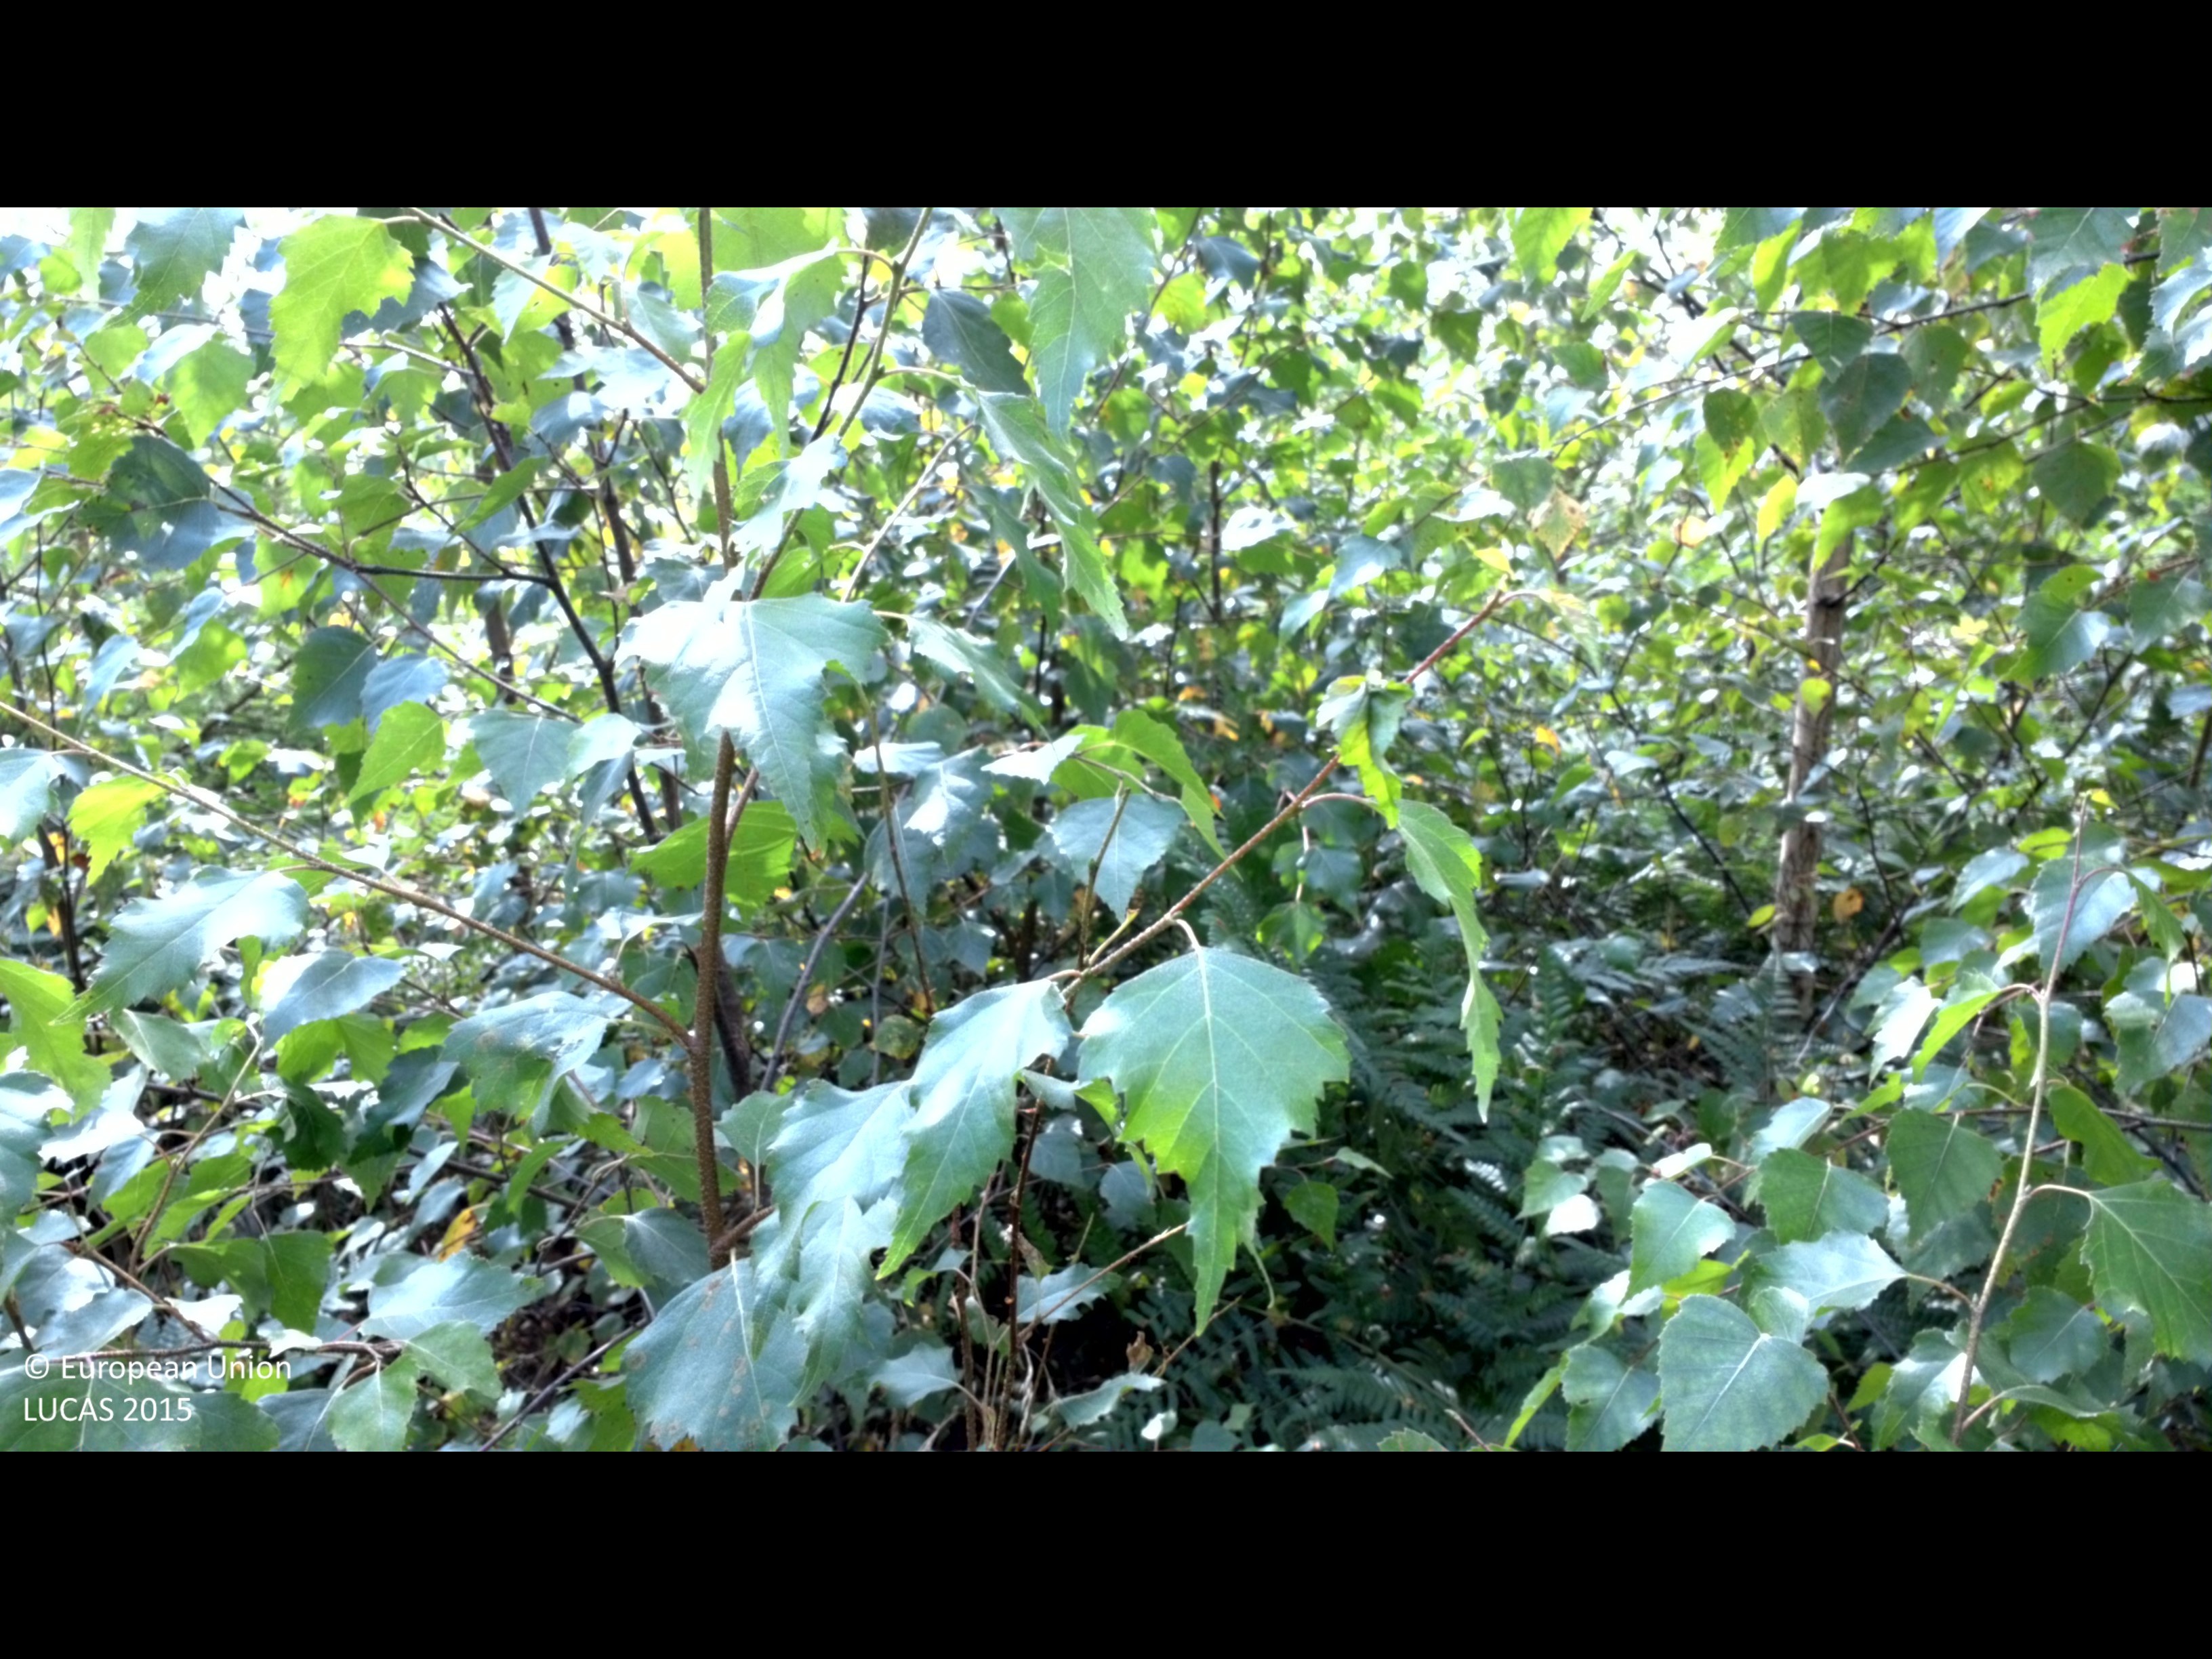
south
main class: Woodland
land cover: Spruce dominated mixed woodland
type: boreal forest
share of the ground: > 75 %
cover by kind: broadleaved forest trees 45 %, coniferous forest trees 30 %, herbaceous plants 20 %, shrubs 5 %
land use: Forestry
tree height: < 5 m
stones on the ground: < 10 %
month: August
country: SE
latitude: 56.8520
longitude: 13.7844
